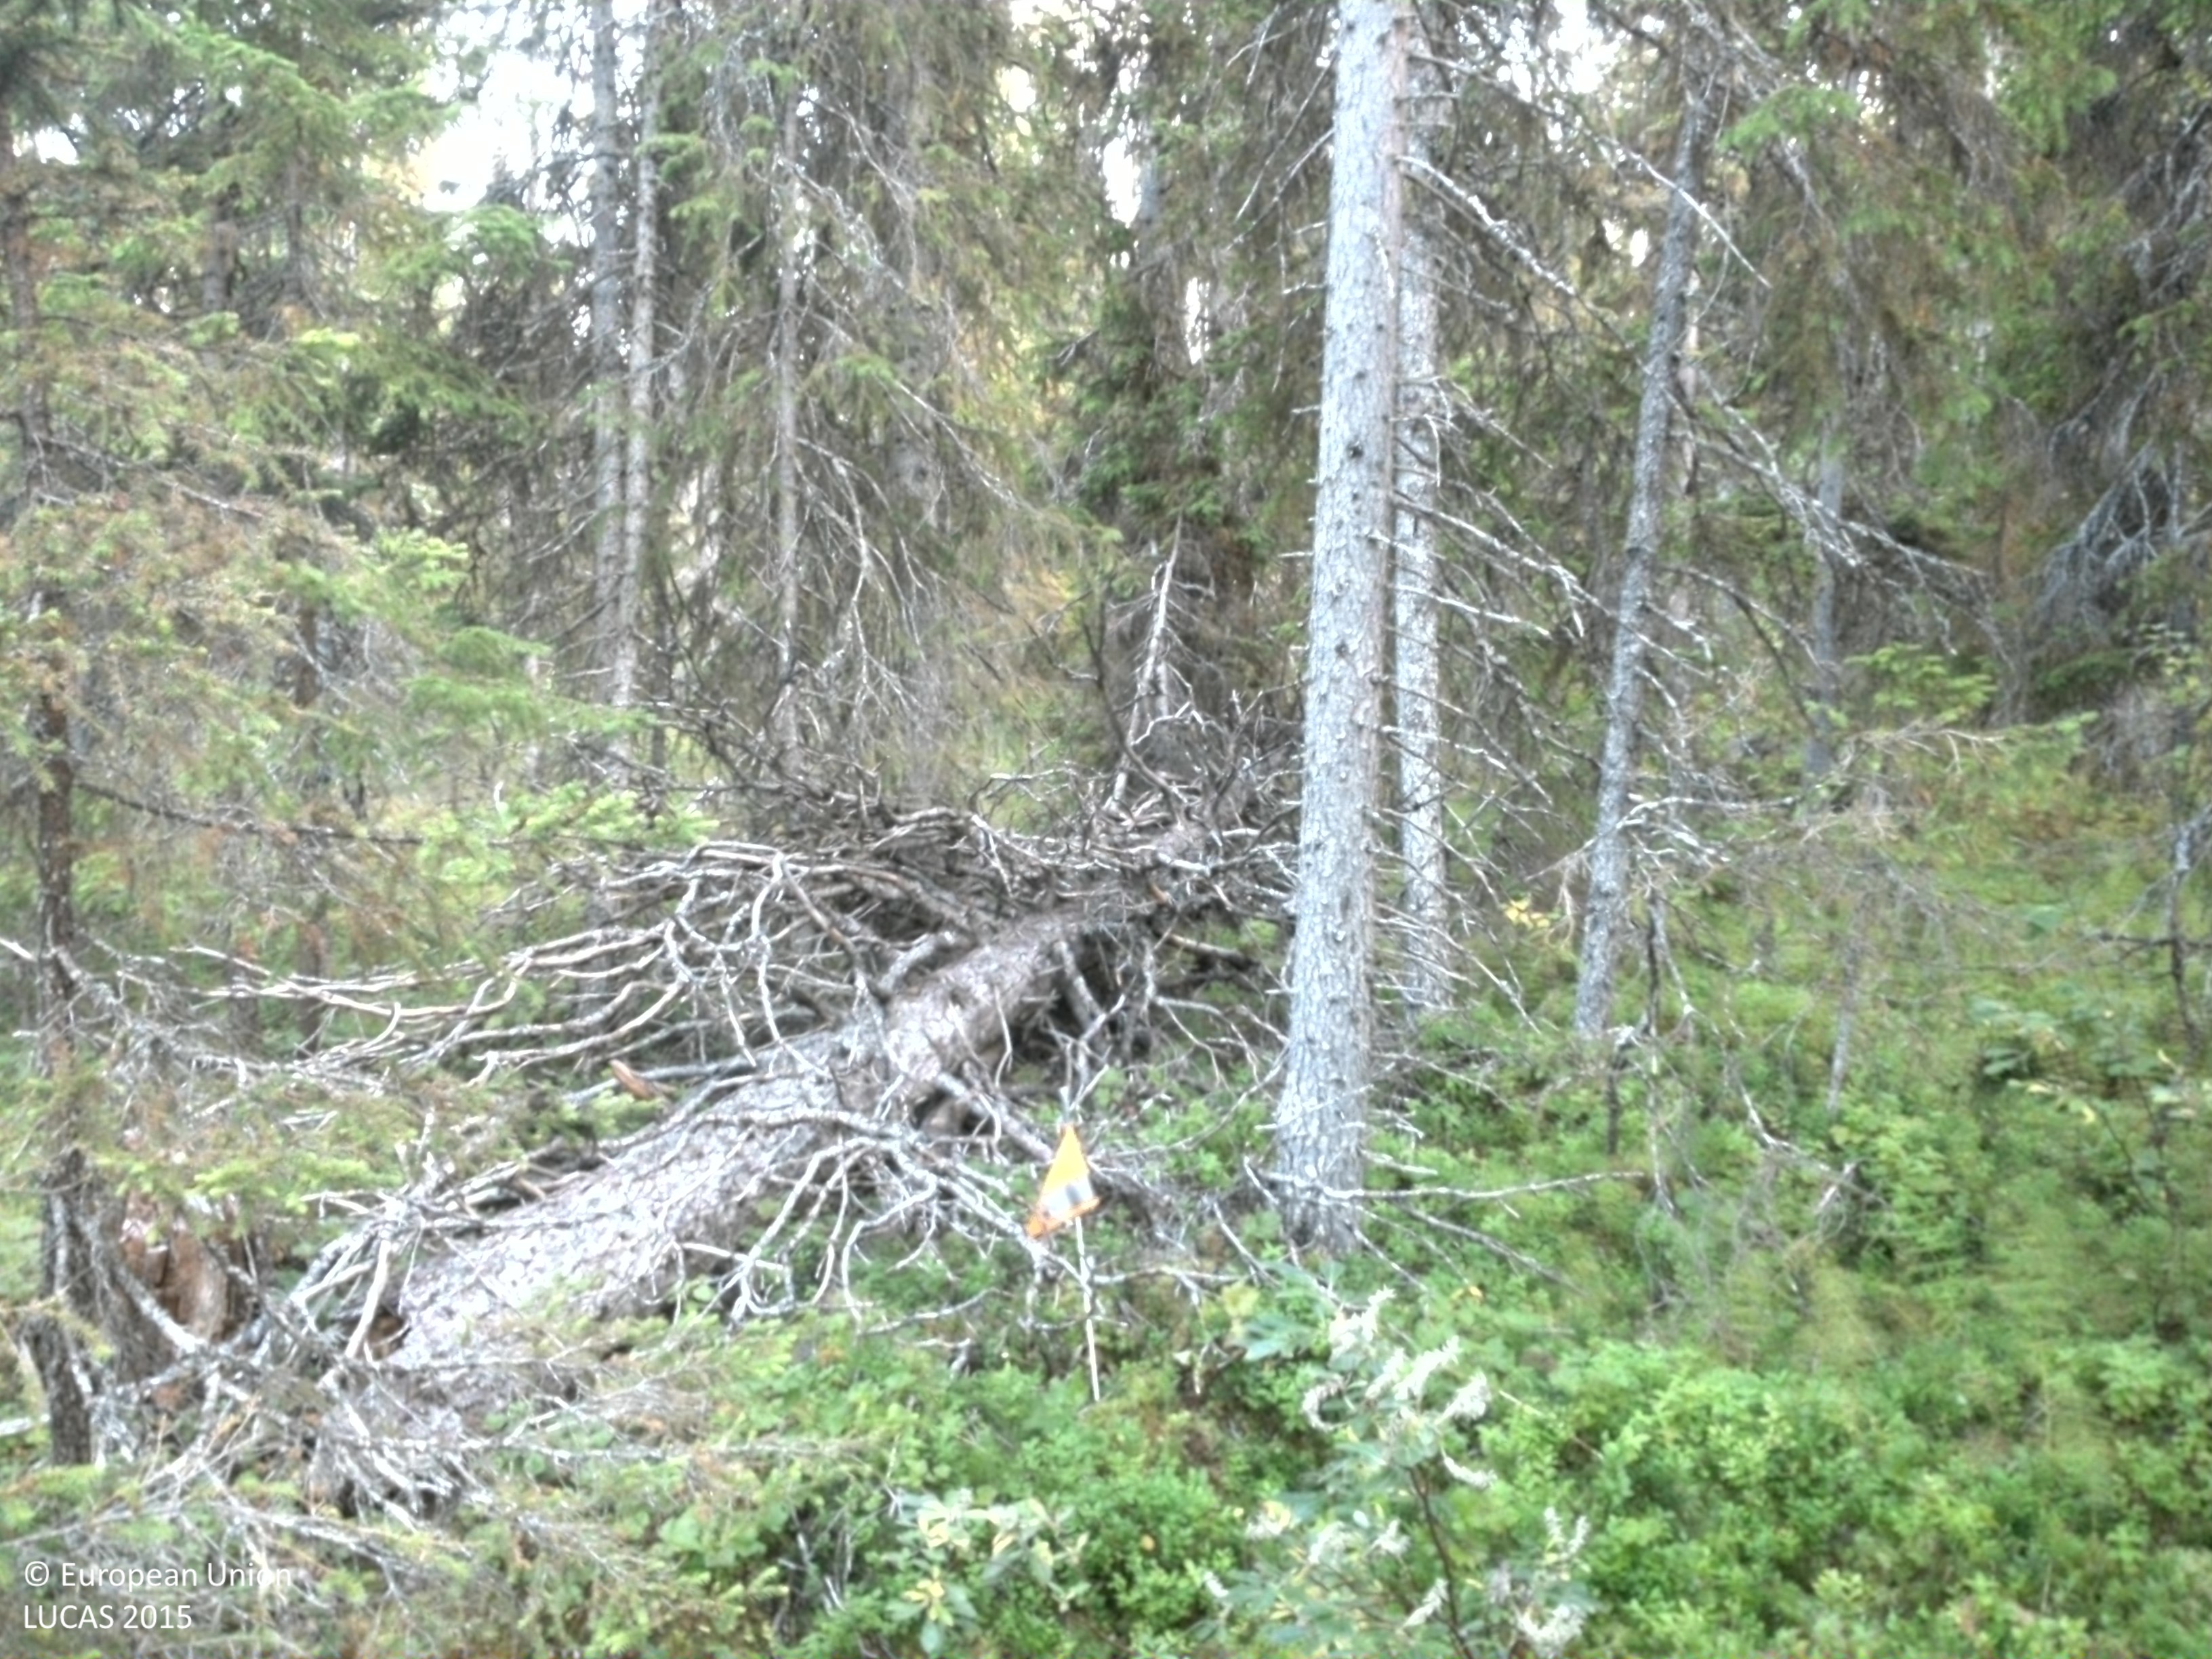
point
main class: Woodland
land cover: Spruce dominated coniferous woodland
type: boreal forest
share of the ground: 25 - 50 %
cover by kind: coniferous forest trees 30 %, shrubs 25 %, herbaceous plants 20 %, lichens and mosses 20 %, broadleaved forest trees 5 %
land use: Amenities, museums, leisure
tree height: > 5 m
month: September
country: SE
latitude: 65.7267
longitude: 16.2174
